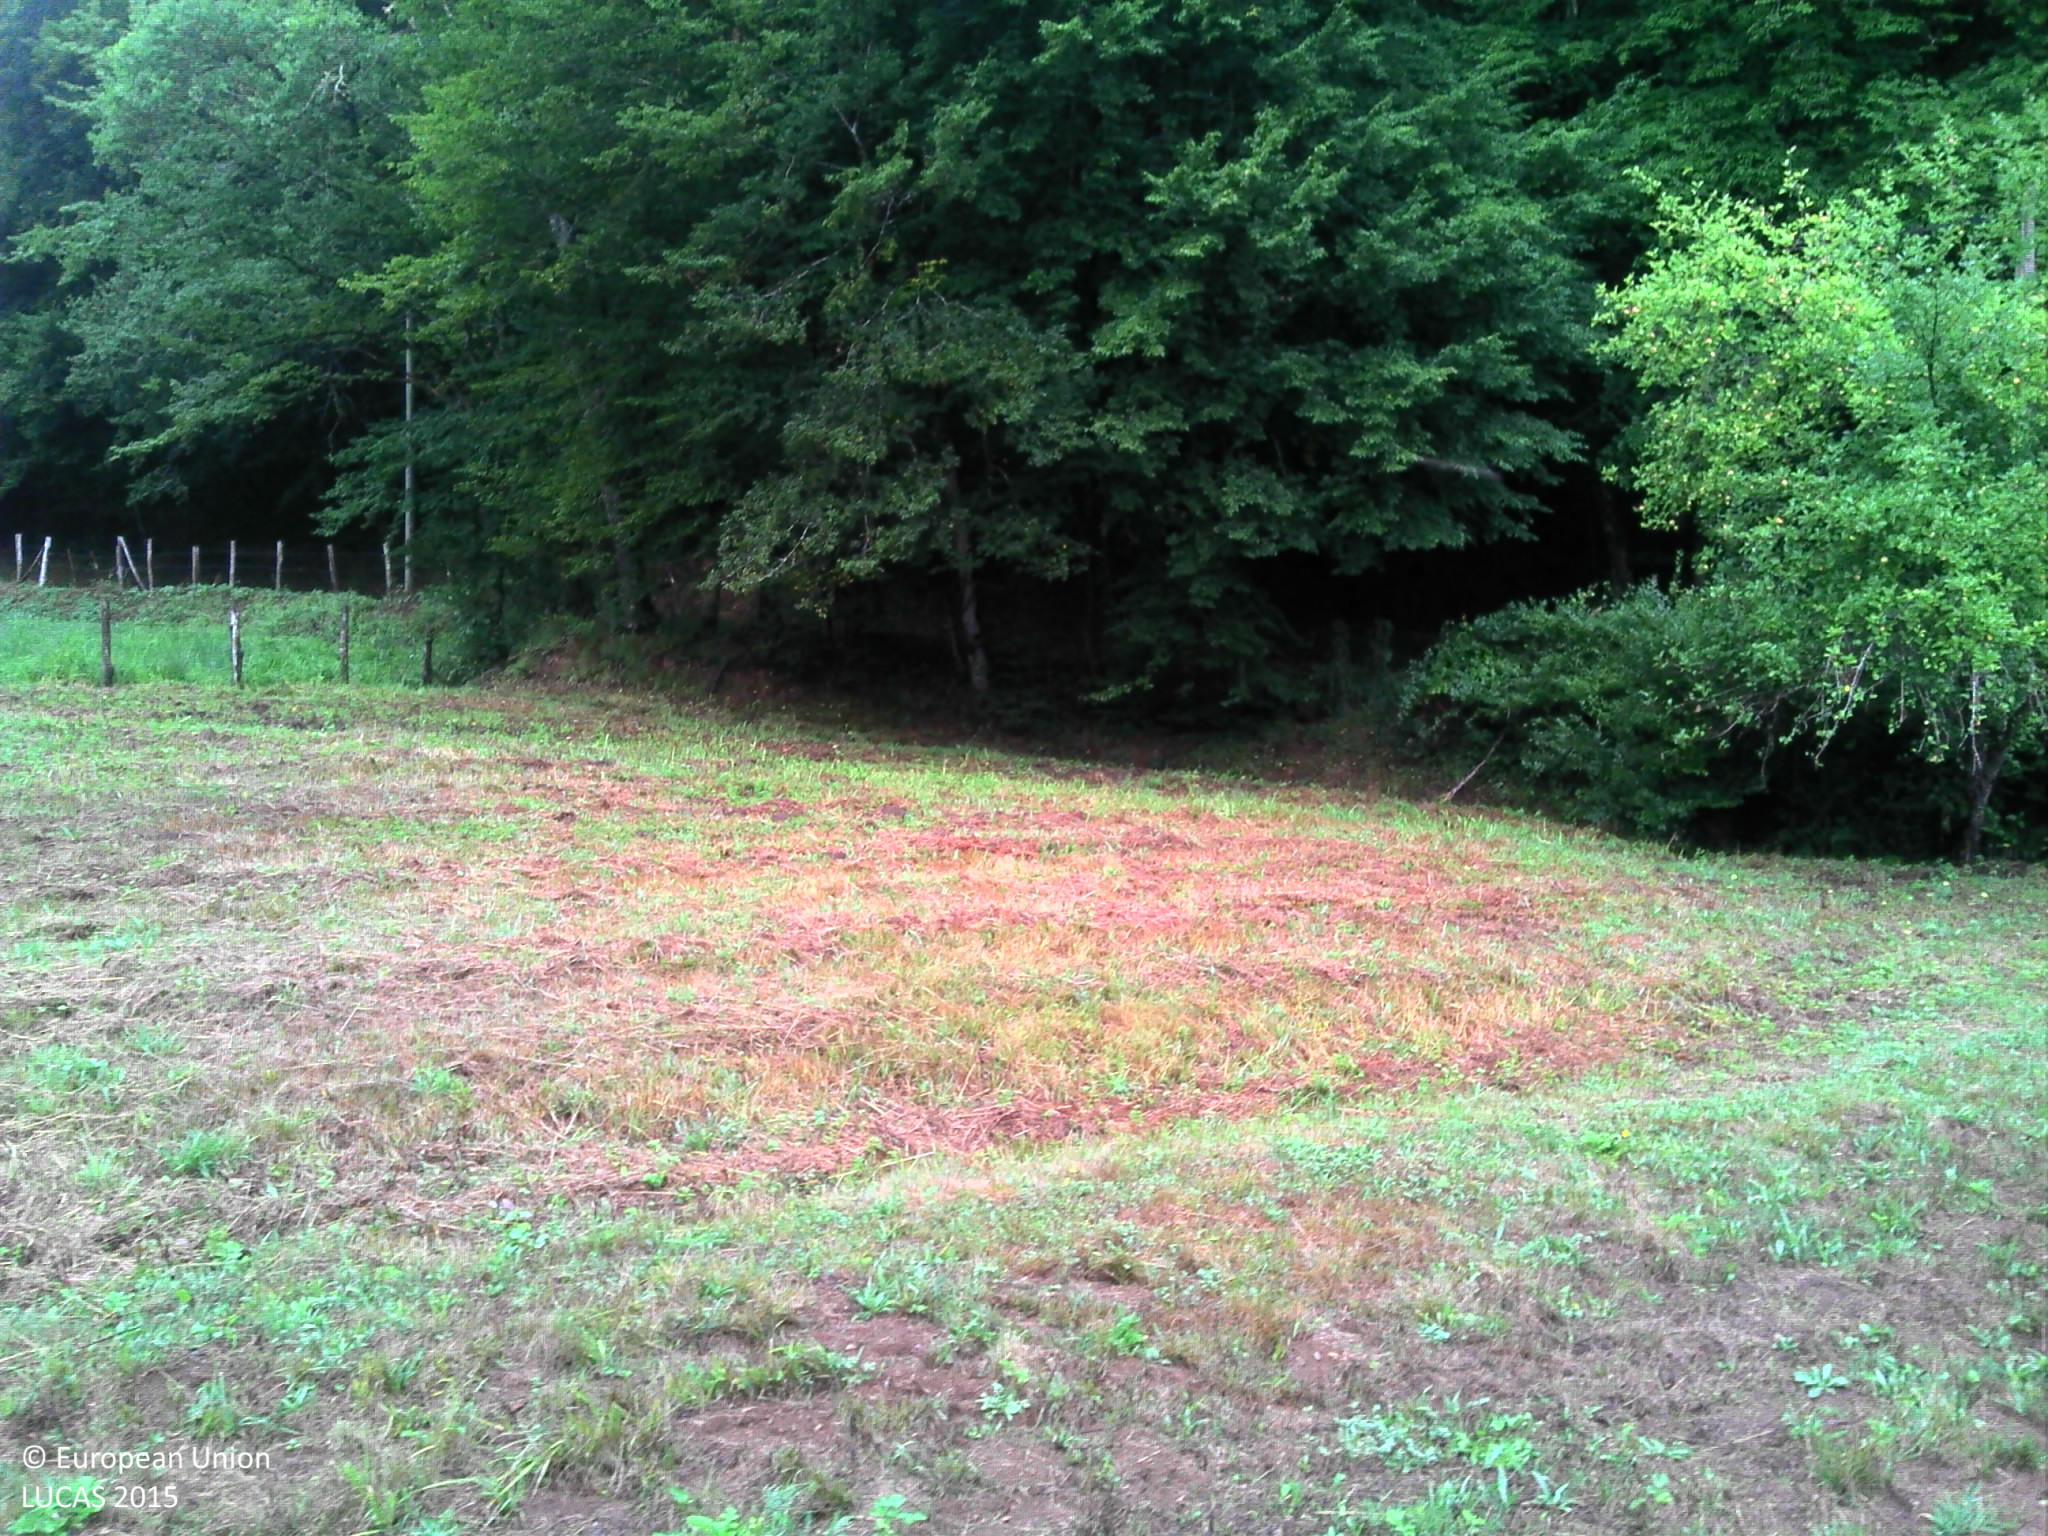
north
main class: Grassland
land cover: Grassland without tree/shrub cover
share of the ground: > 75 %
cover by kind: herbaceous plants 100 %
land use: Agriculture (excluding fallow land and kitchen gardens)
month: August
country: FR
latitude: 45.3492
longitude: 1.8145
